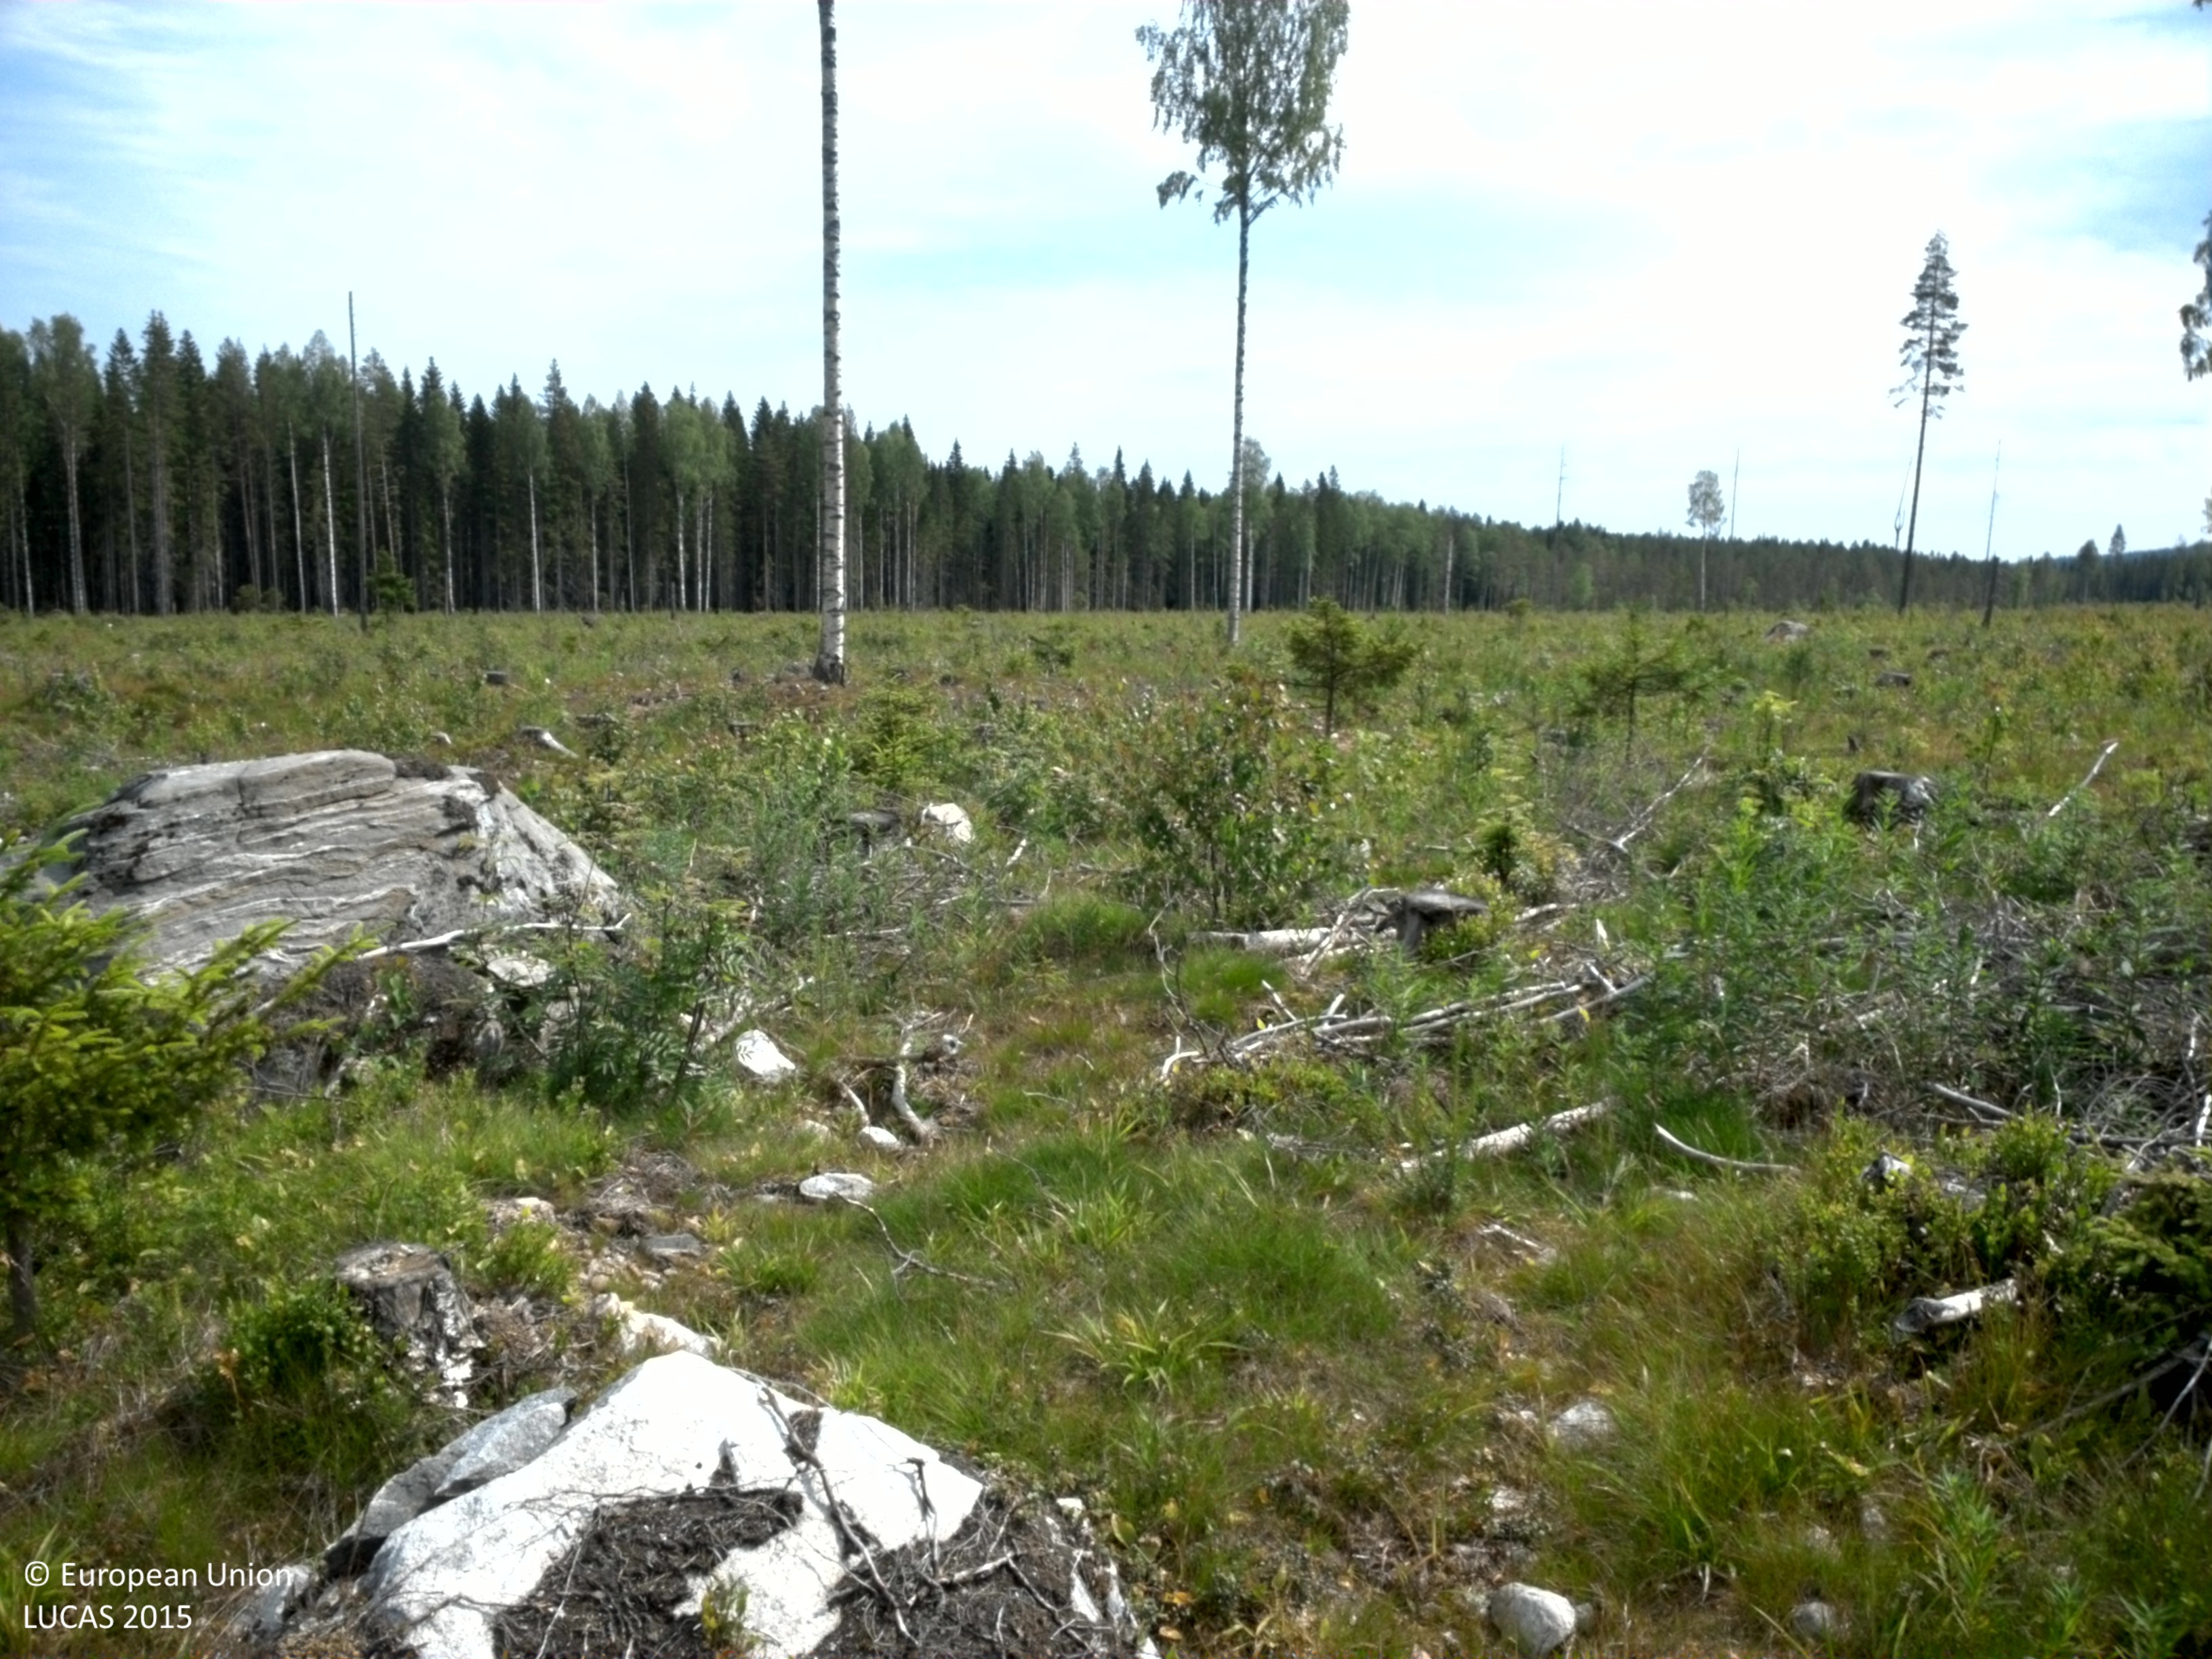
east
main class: Grassland
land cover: Grassland with sparse tree/shrub cover
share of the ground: > 75 %
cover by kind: herbaceous plants 75 %, shrubs 10 %, unconsolidated bare surface 10 %, broadleaved forest trees 5 %
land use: Forestry
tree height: > 5 m
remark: Clear cut
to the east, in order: Grassland with sparse tree/shrub cover; Broadleaved woodland; Spruce dominated coniferous woodland; Other mixed woodland
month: July
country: SE
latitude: 64.4400
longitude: 20.9283
